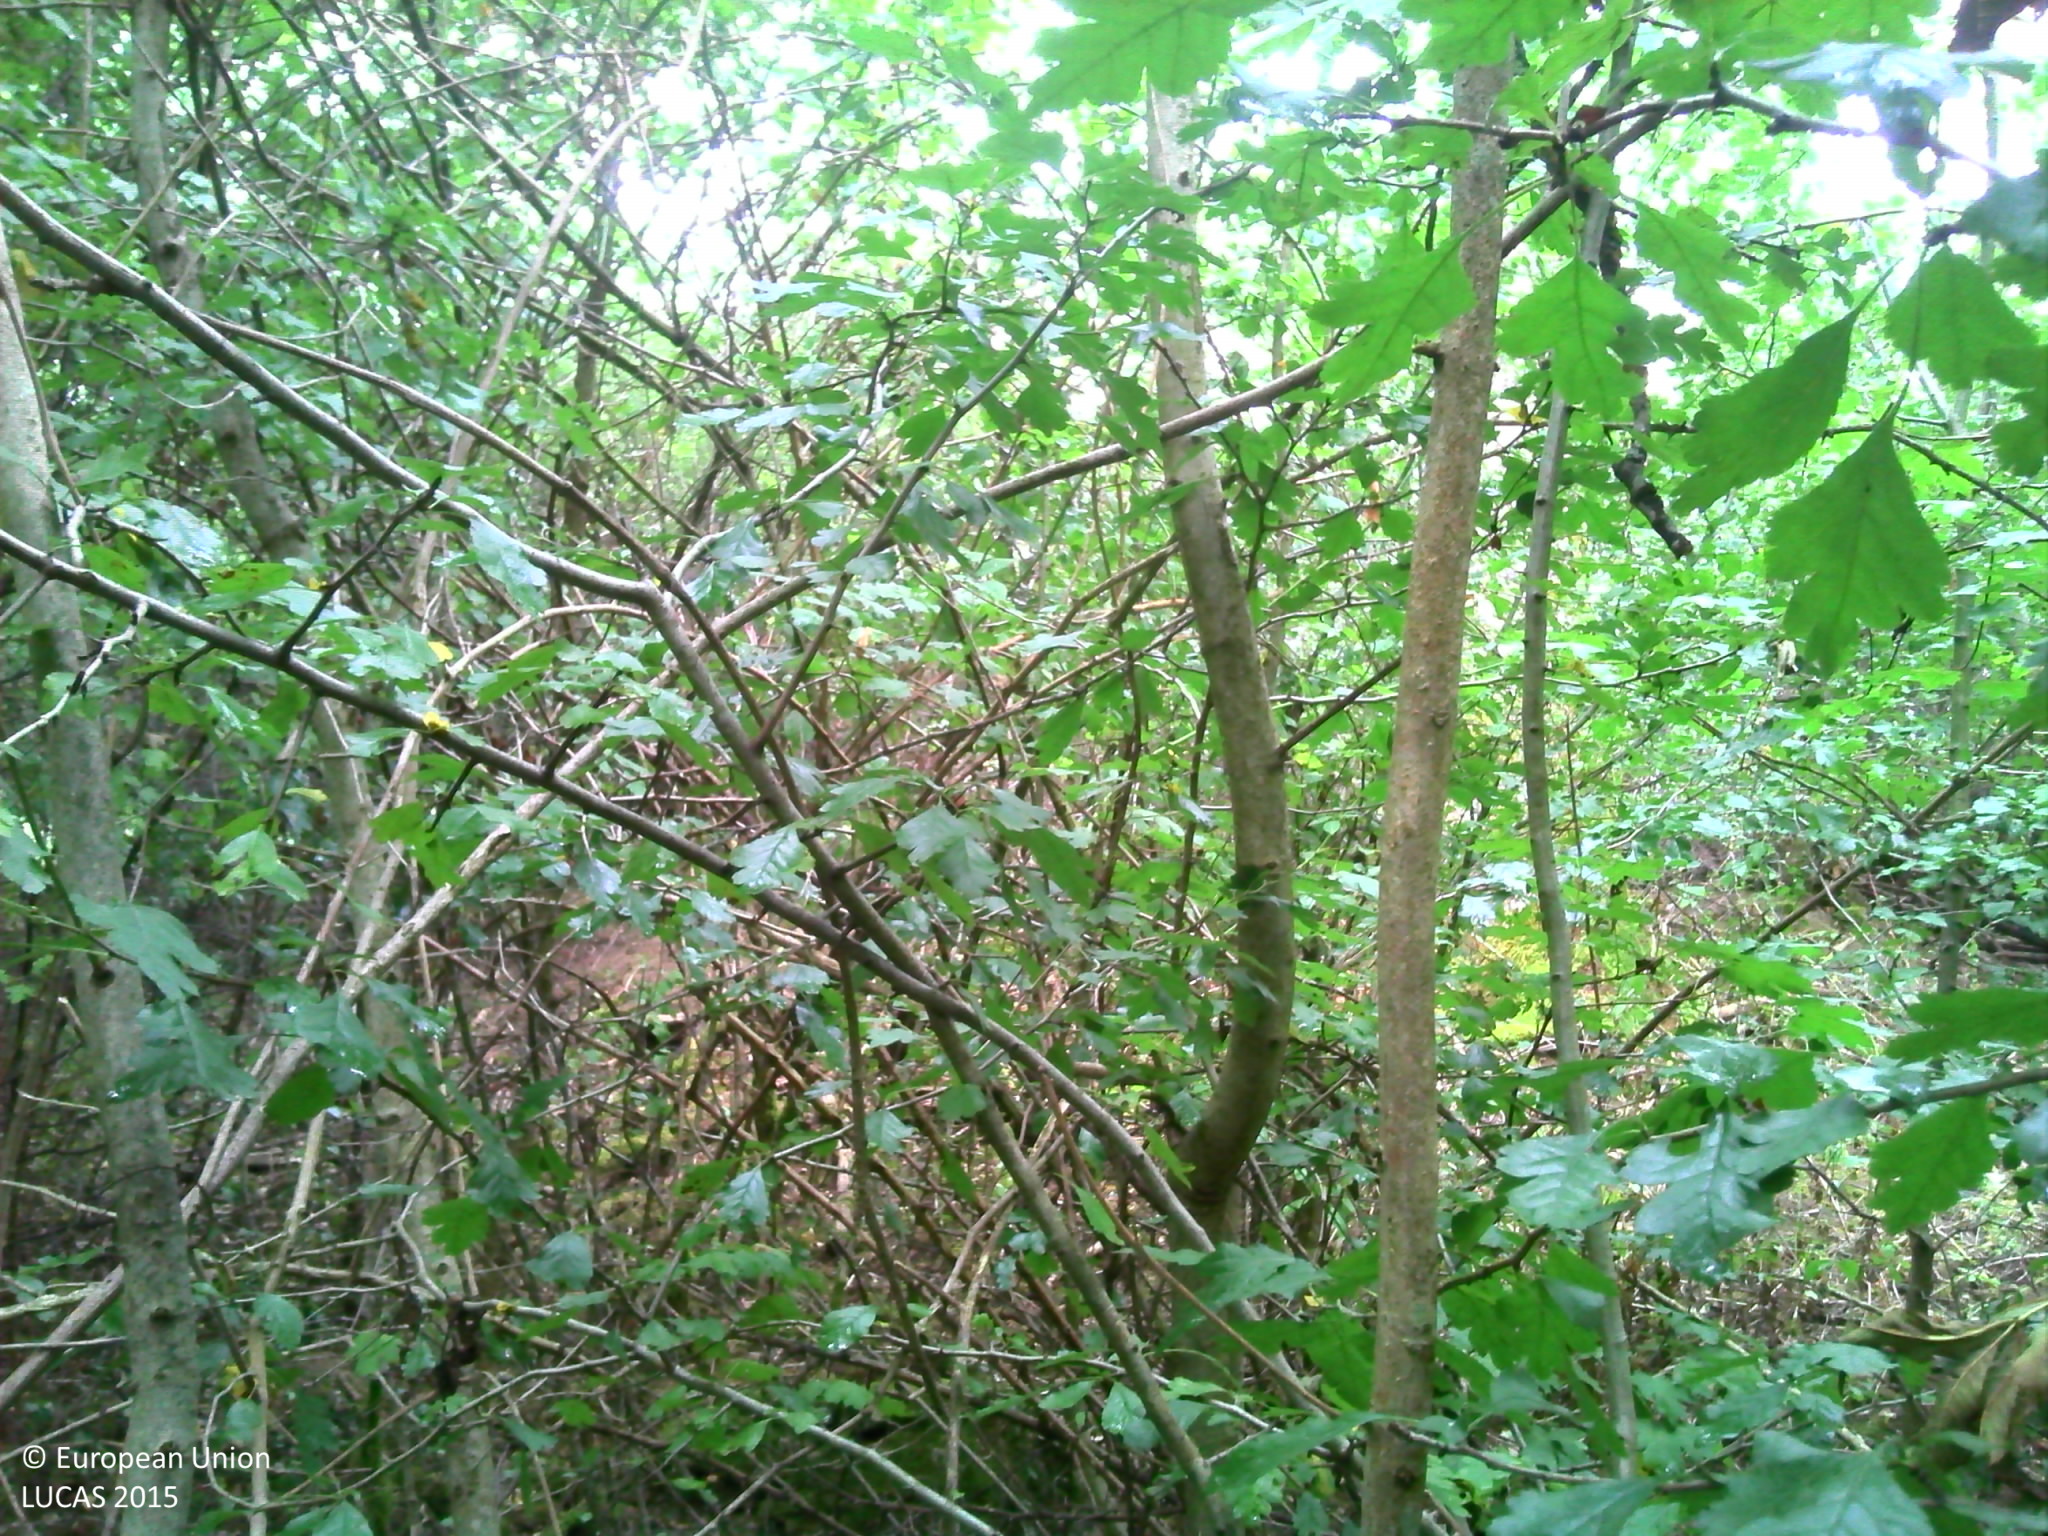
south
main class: Woodland
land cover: Broadleaved woodland
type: mesophytic deciduous forest
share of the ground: > 75 %
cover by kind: broadleaved forest trees 100 %
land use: Semi-natural and natural areas not in use
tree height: > 5 m
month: August
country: FR
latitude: 47.3792
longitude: 4.7947
